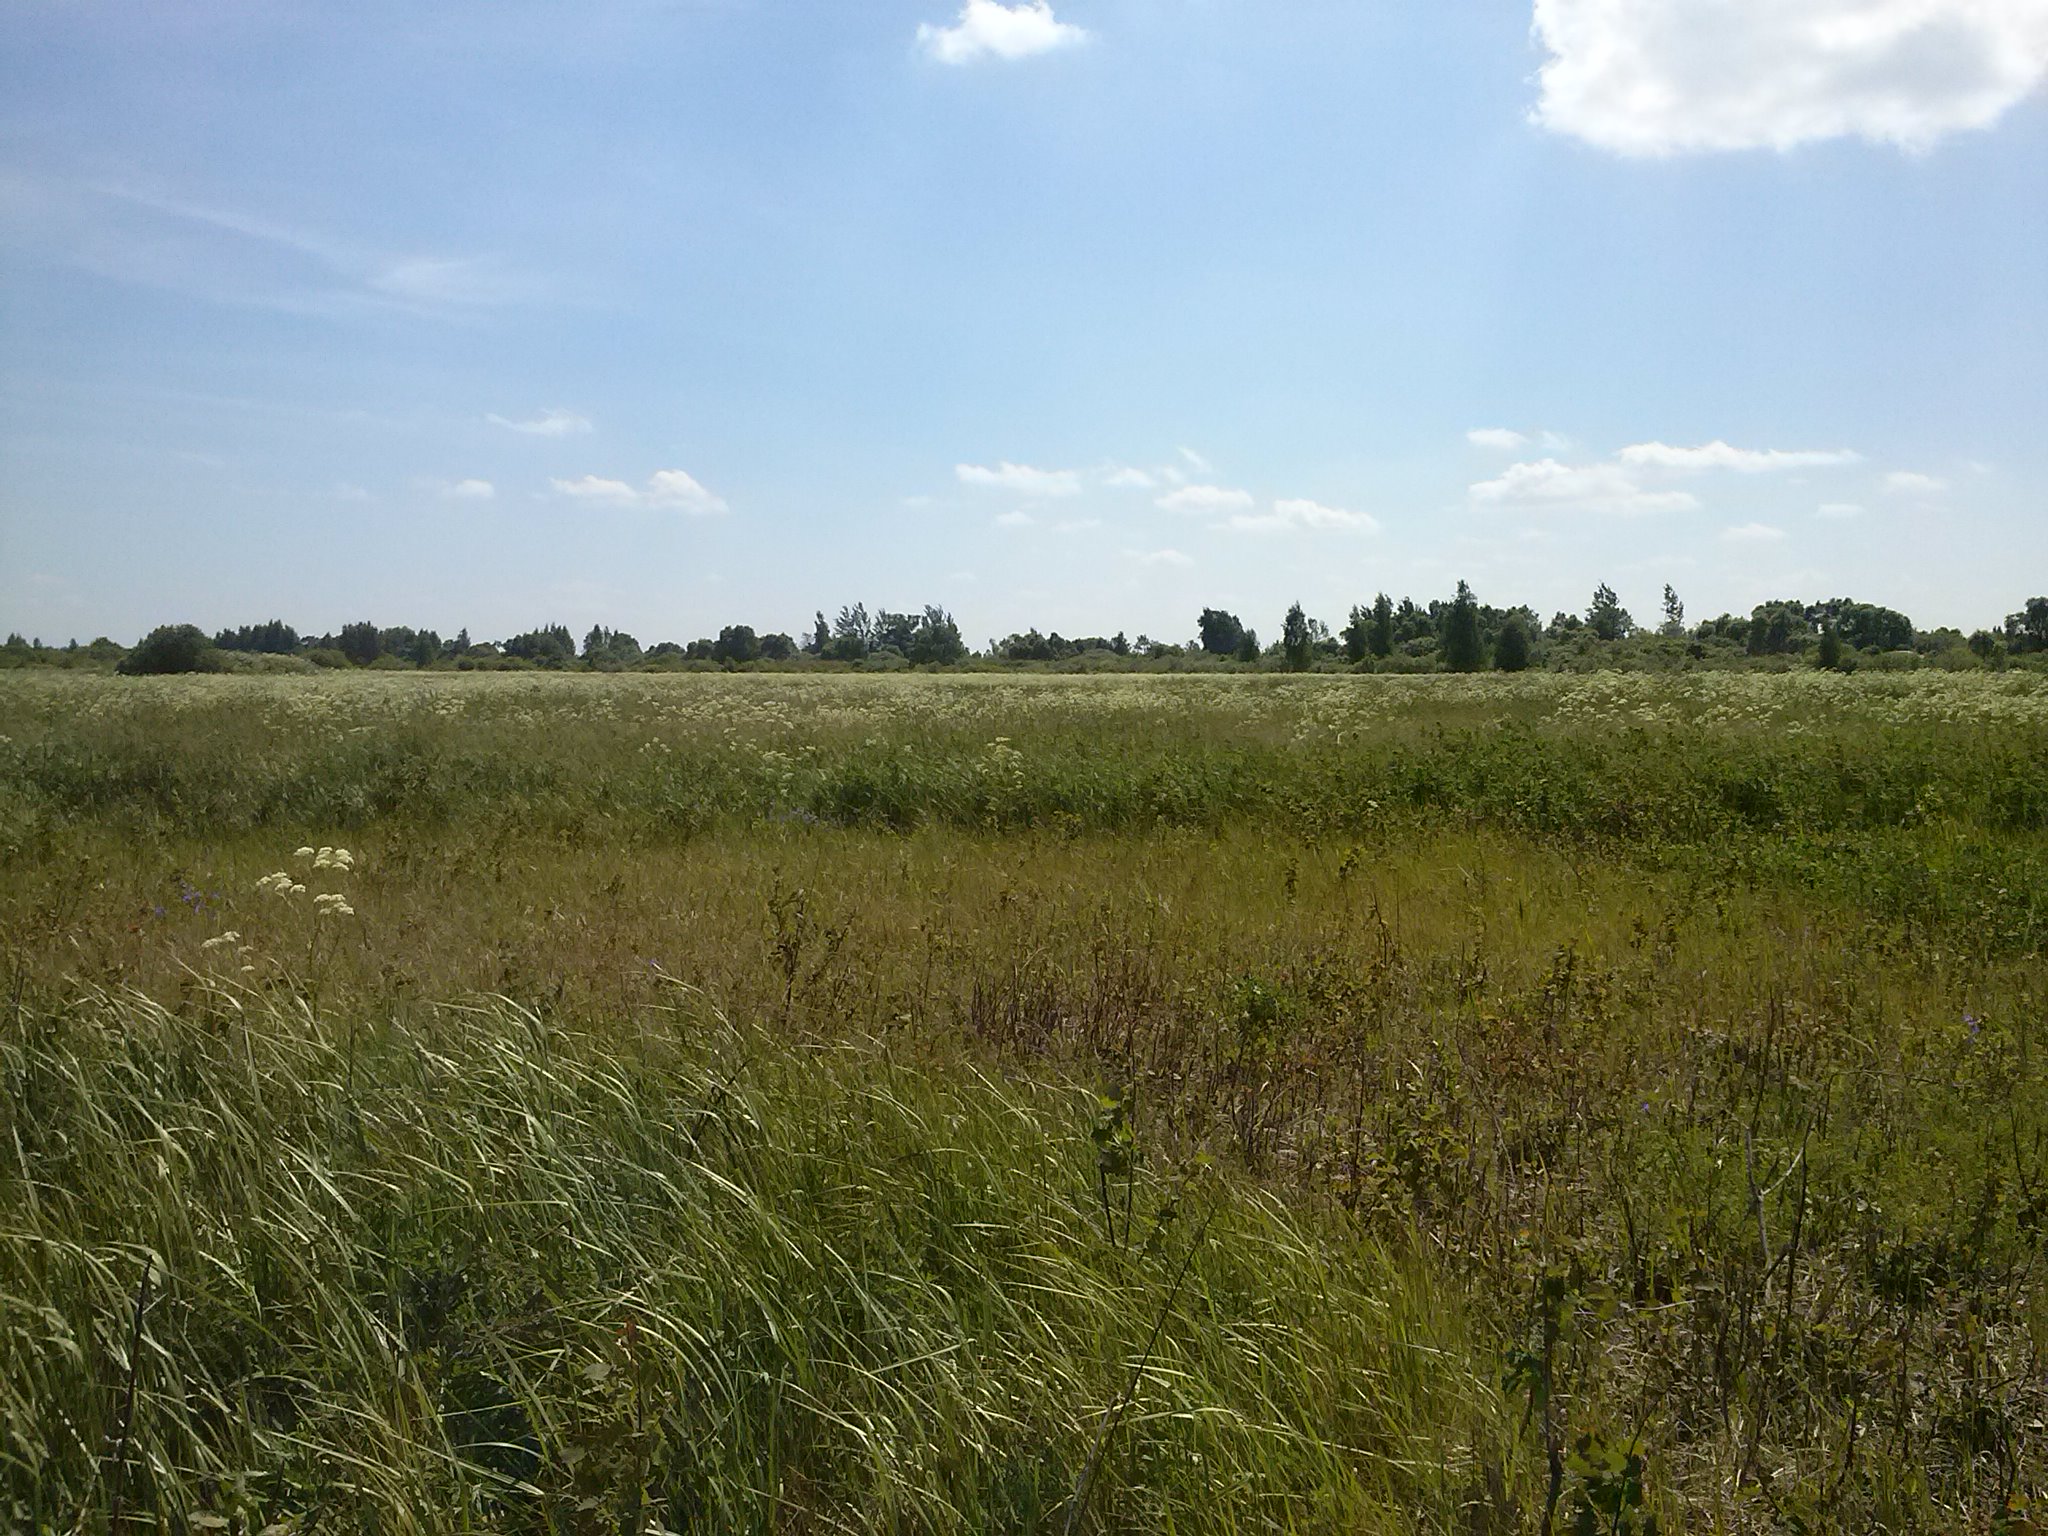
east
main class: Grassland
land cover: Grassland with sparse tree/shrub cover
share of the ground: > 75 %
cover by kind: herbaceous plants 85 %, shrubs 10 %, broadleaved forest trees 5 %
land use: Agriculture (excluding fallow land and kitchen gardens)
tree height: < 5 m
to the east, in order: Grassland with sparse tree/shrub cover; Spontaneously vegetated surfaces; Abandoned hedges; Inland fresh running water; Inland marshes; Abandoned hedges
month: June
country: LV
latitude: 56.8254
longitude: 27.0234
